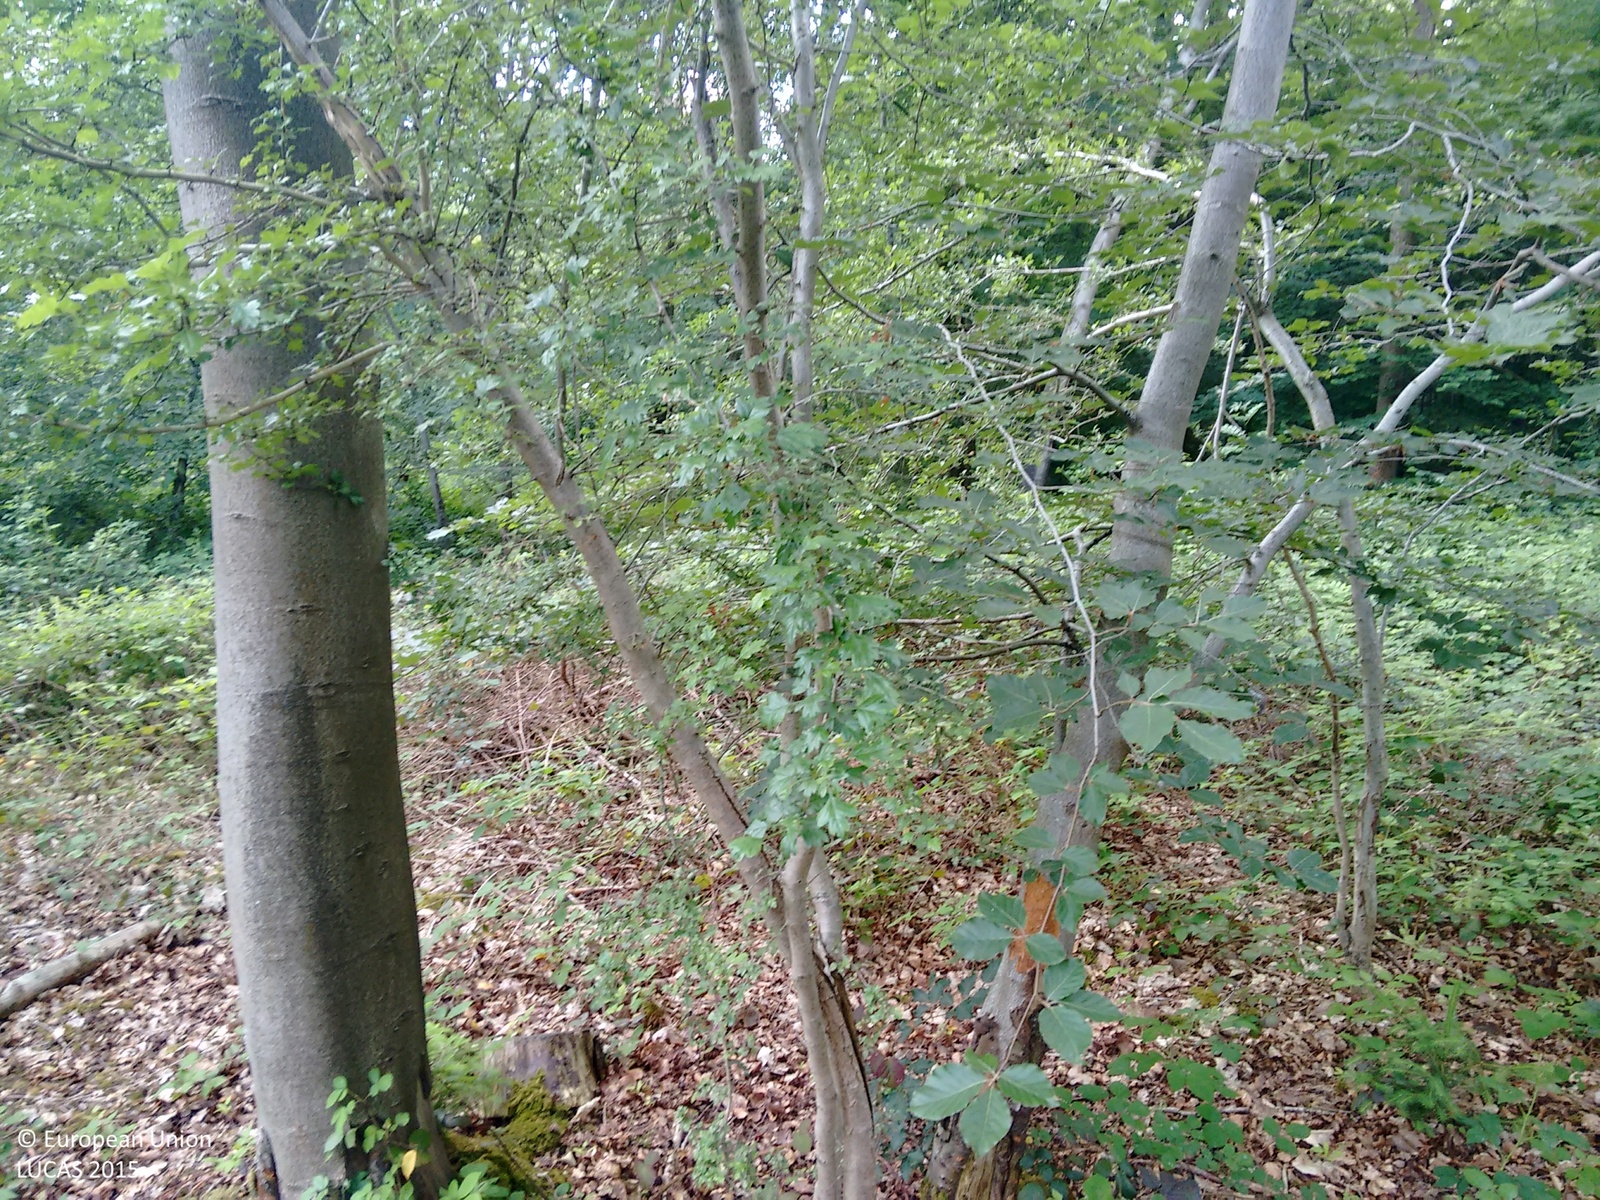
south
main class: Woodland
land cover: Broadleaved woodland
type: mesophytic deciduous forest
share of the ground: > 75 %
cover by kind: broadleaved forest trees 100 %
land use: Forestry
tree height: > 5 m
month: June
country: GB
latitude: 51.5731
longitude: -1.9322
